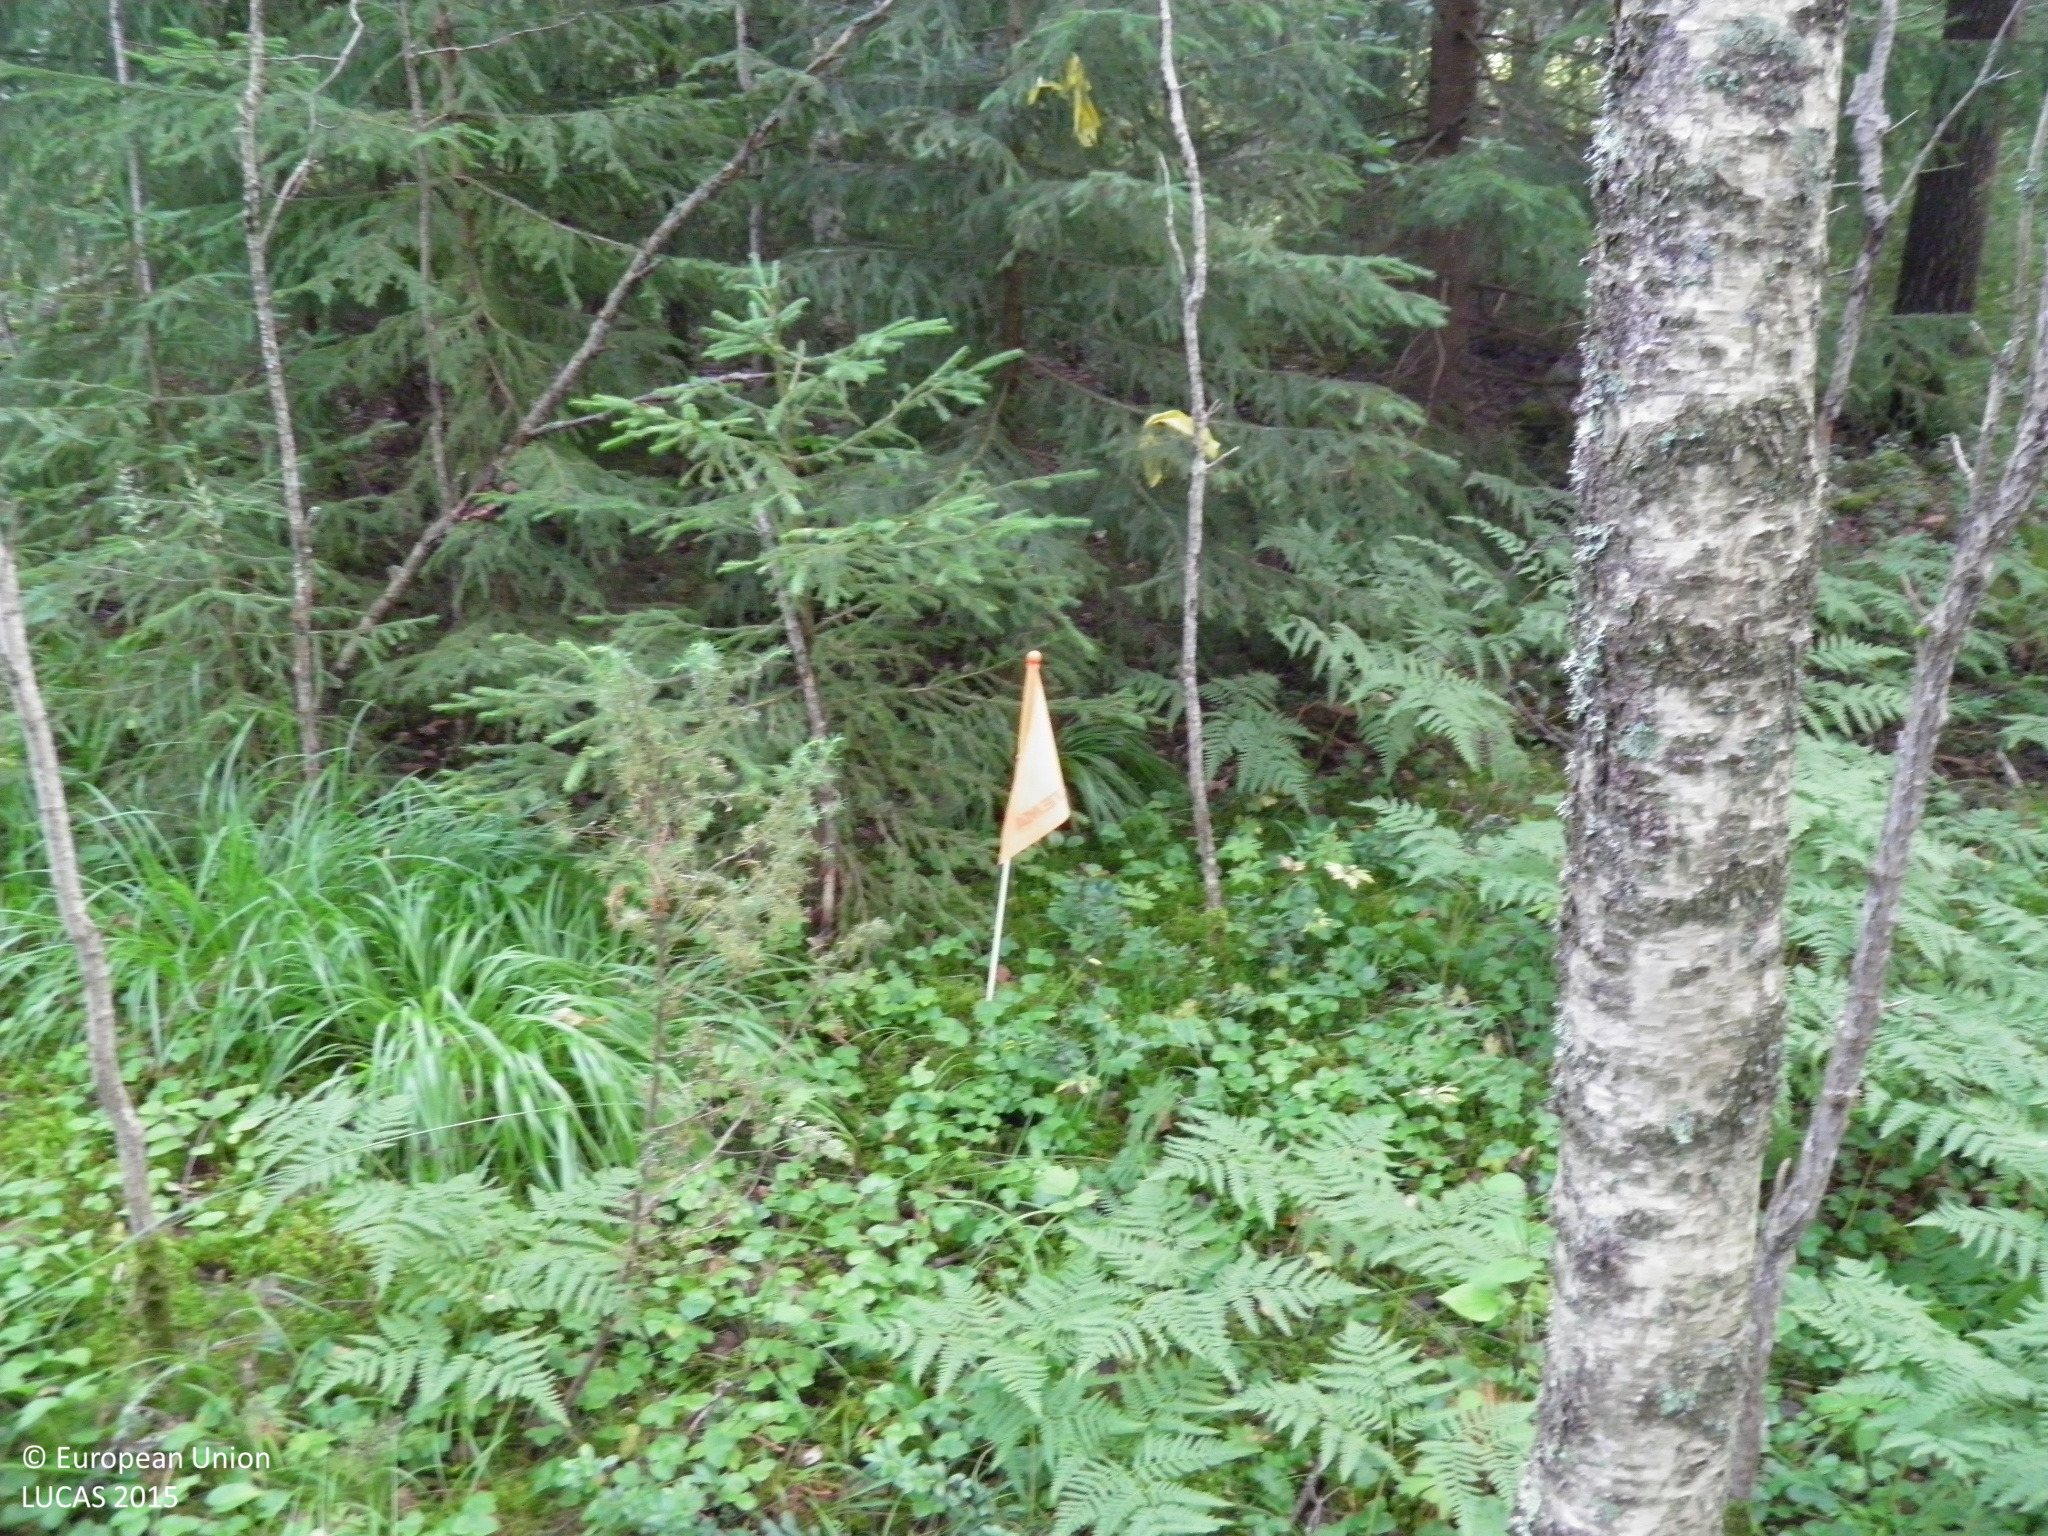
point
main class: Woodland
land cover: Pine dominated mixed woodland
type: hemiboreal forest and nemoral coniferous forest and mixed broadleaved-coniferous forest
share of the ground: > 75 %
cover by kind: broadleaved forest trees 45 %, coniferous forest trees 35 %, shrubs 10 %, herbaceous plants 5 %, lichens and mosses 5 %
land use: Forestry
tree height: > 5 m
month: July
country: FI
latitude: 60.0921
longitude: 22.7527
